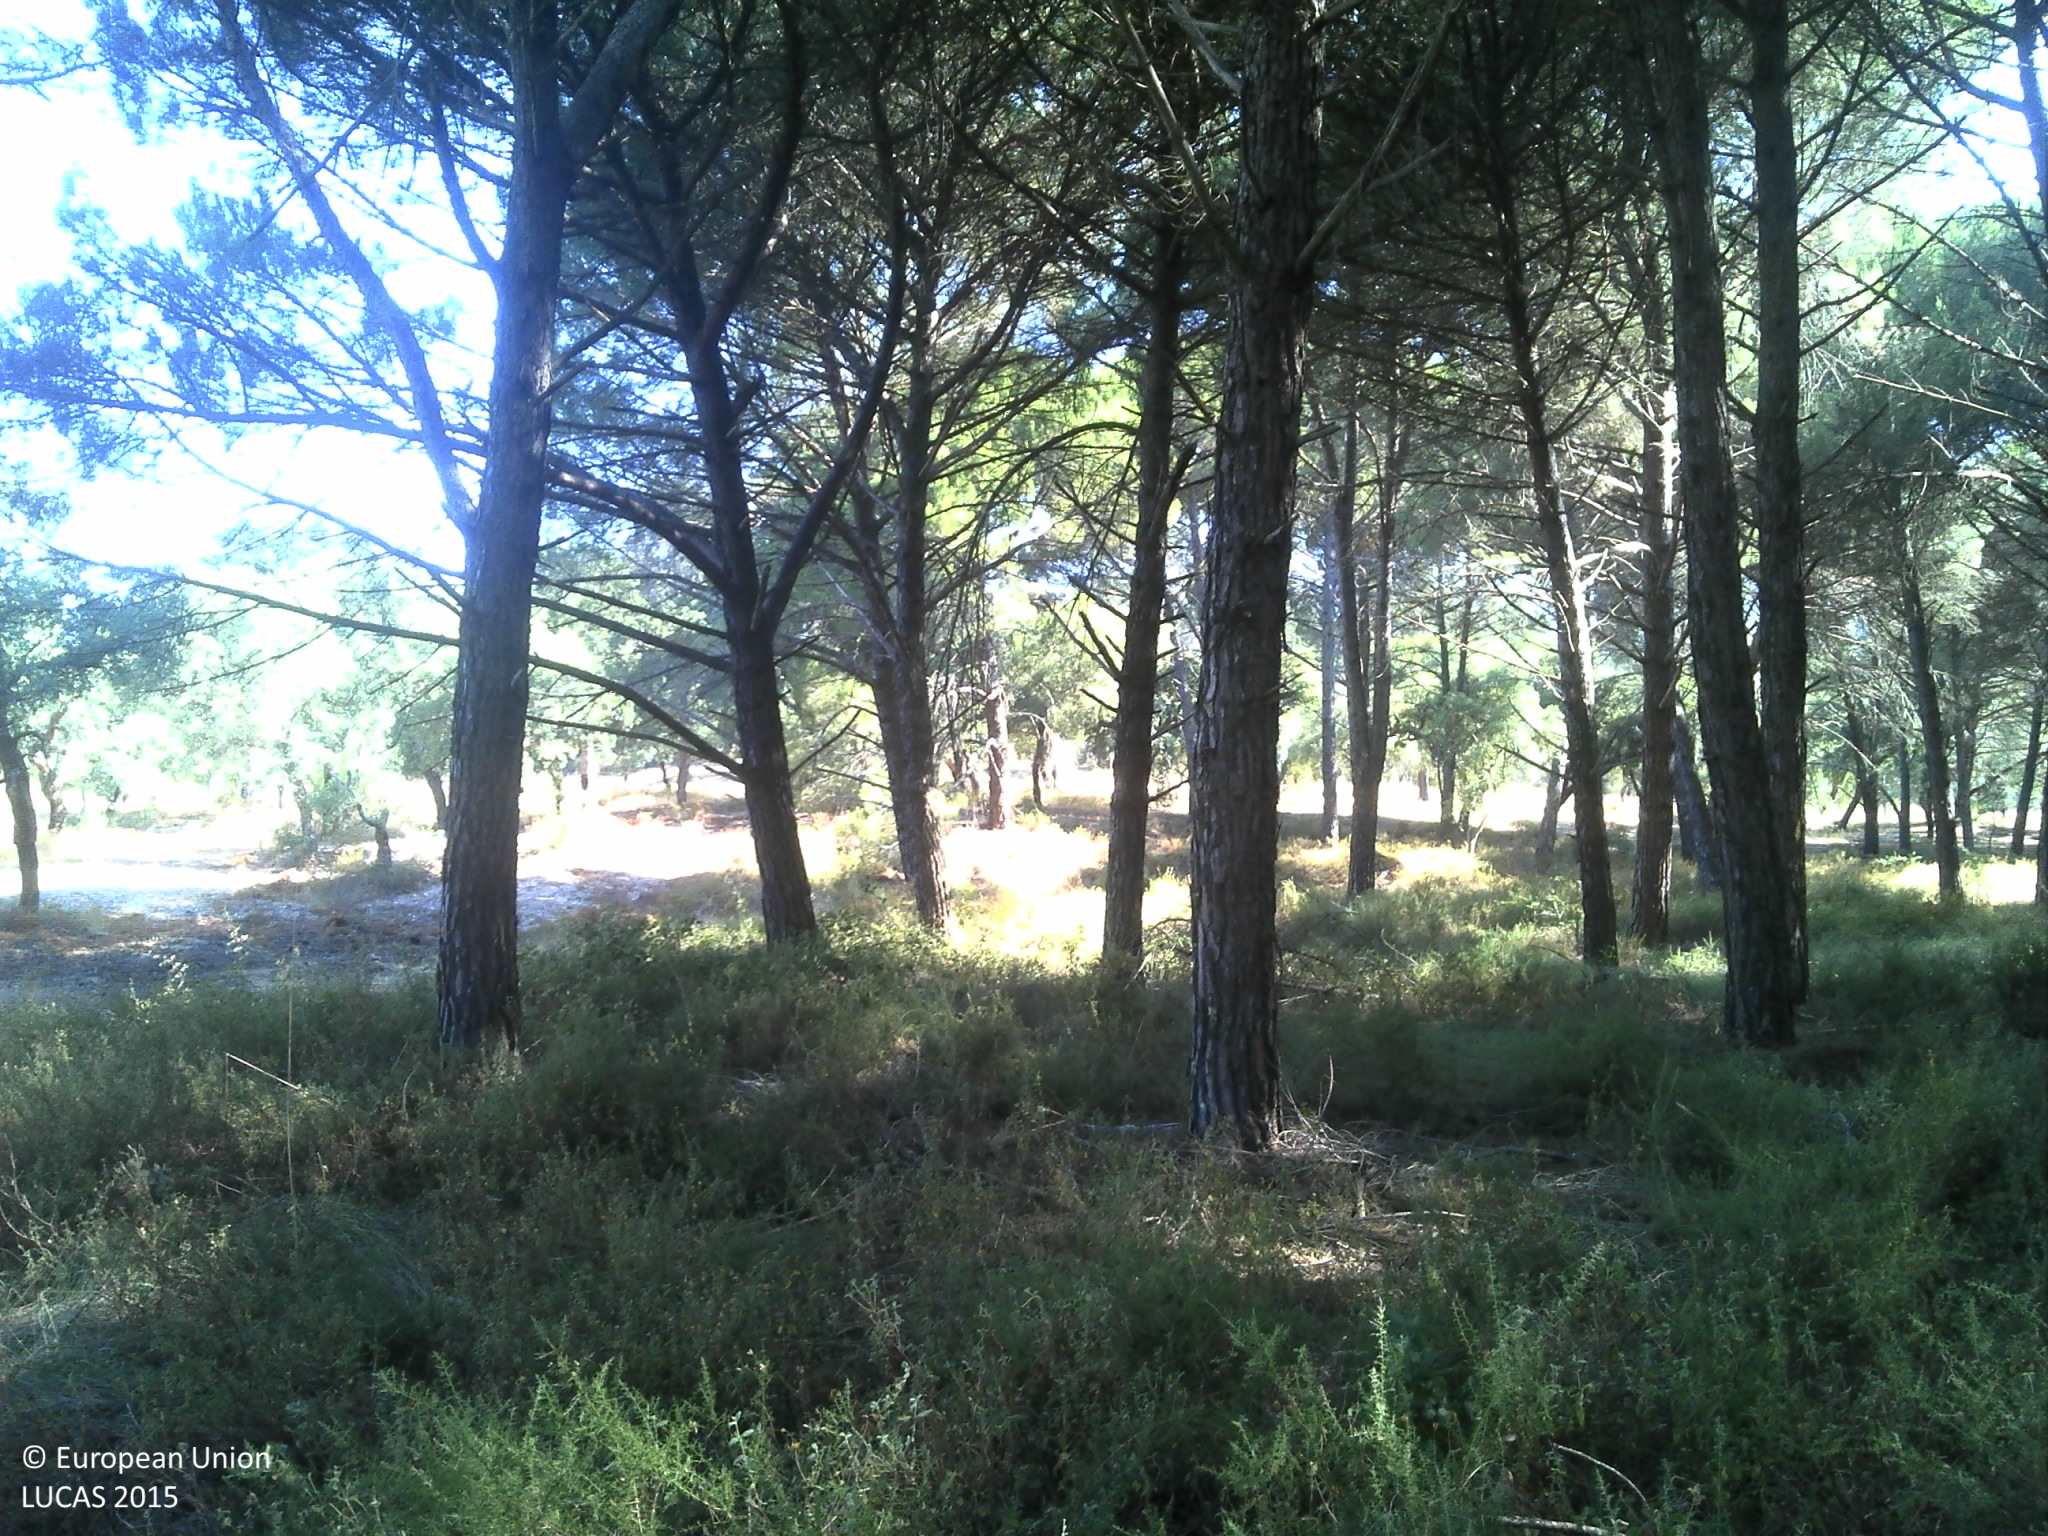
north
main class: Woodland
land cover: Pine dominated coniferous woodland
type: coniferous forest of the mediterranean region
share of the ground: 50 - 75 %
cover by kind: coniferous forest trees 75 %, unconsolidated bare surface 15 %, broadleaved forest trees 10 %
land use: Forestry
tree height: > 5 m
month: June
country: PT
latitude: 39.2660
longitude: -8.4130
